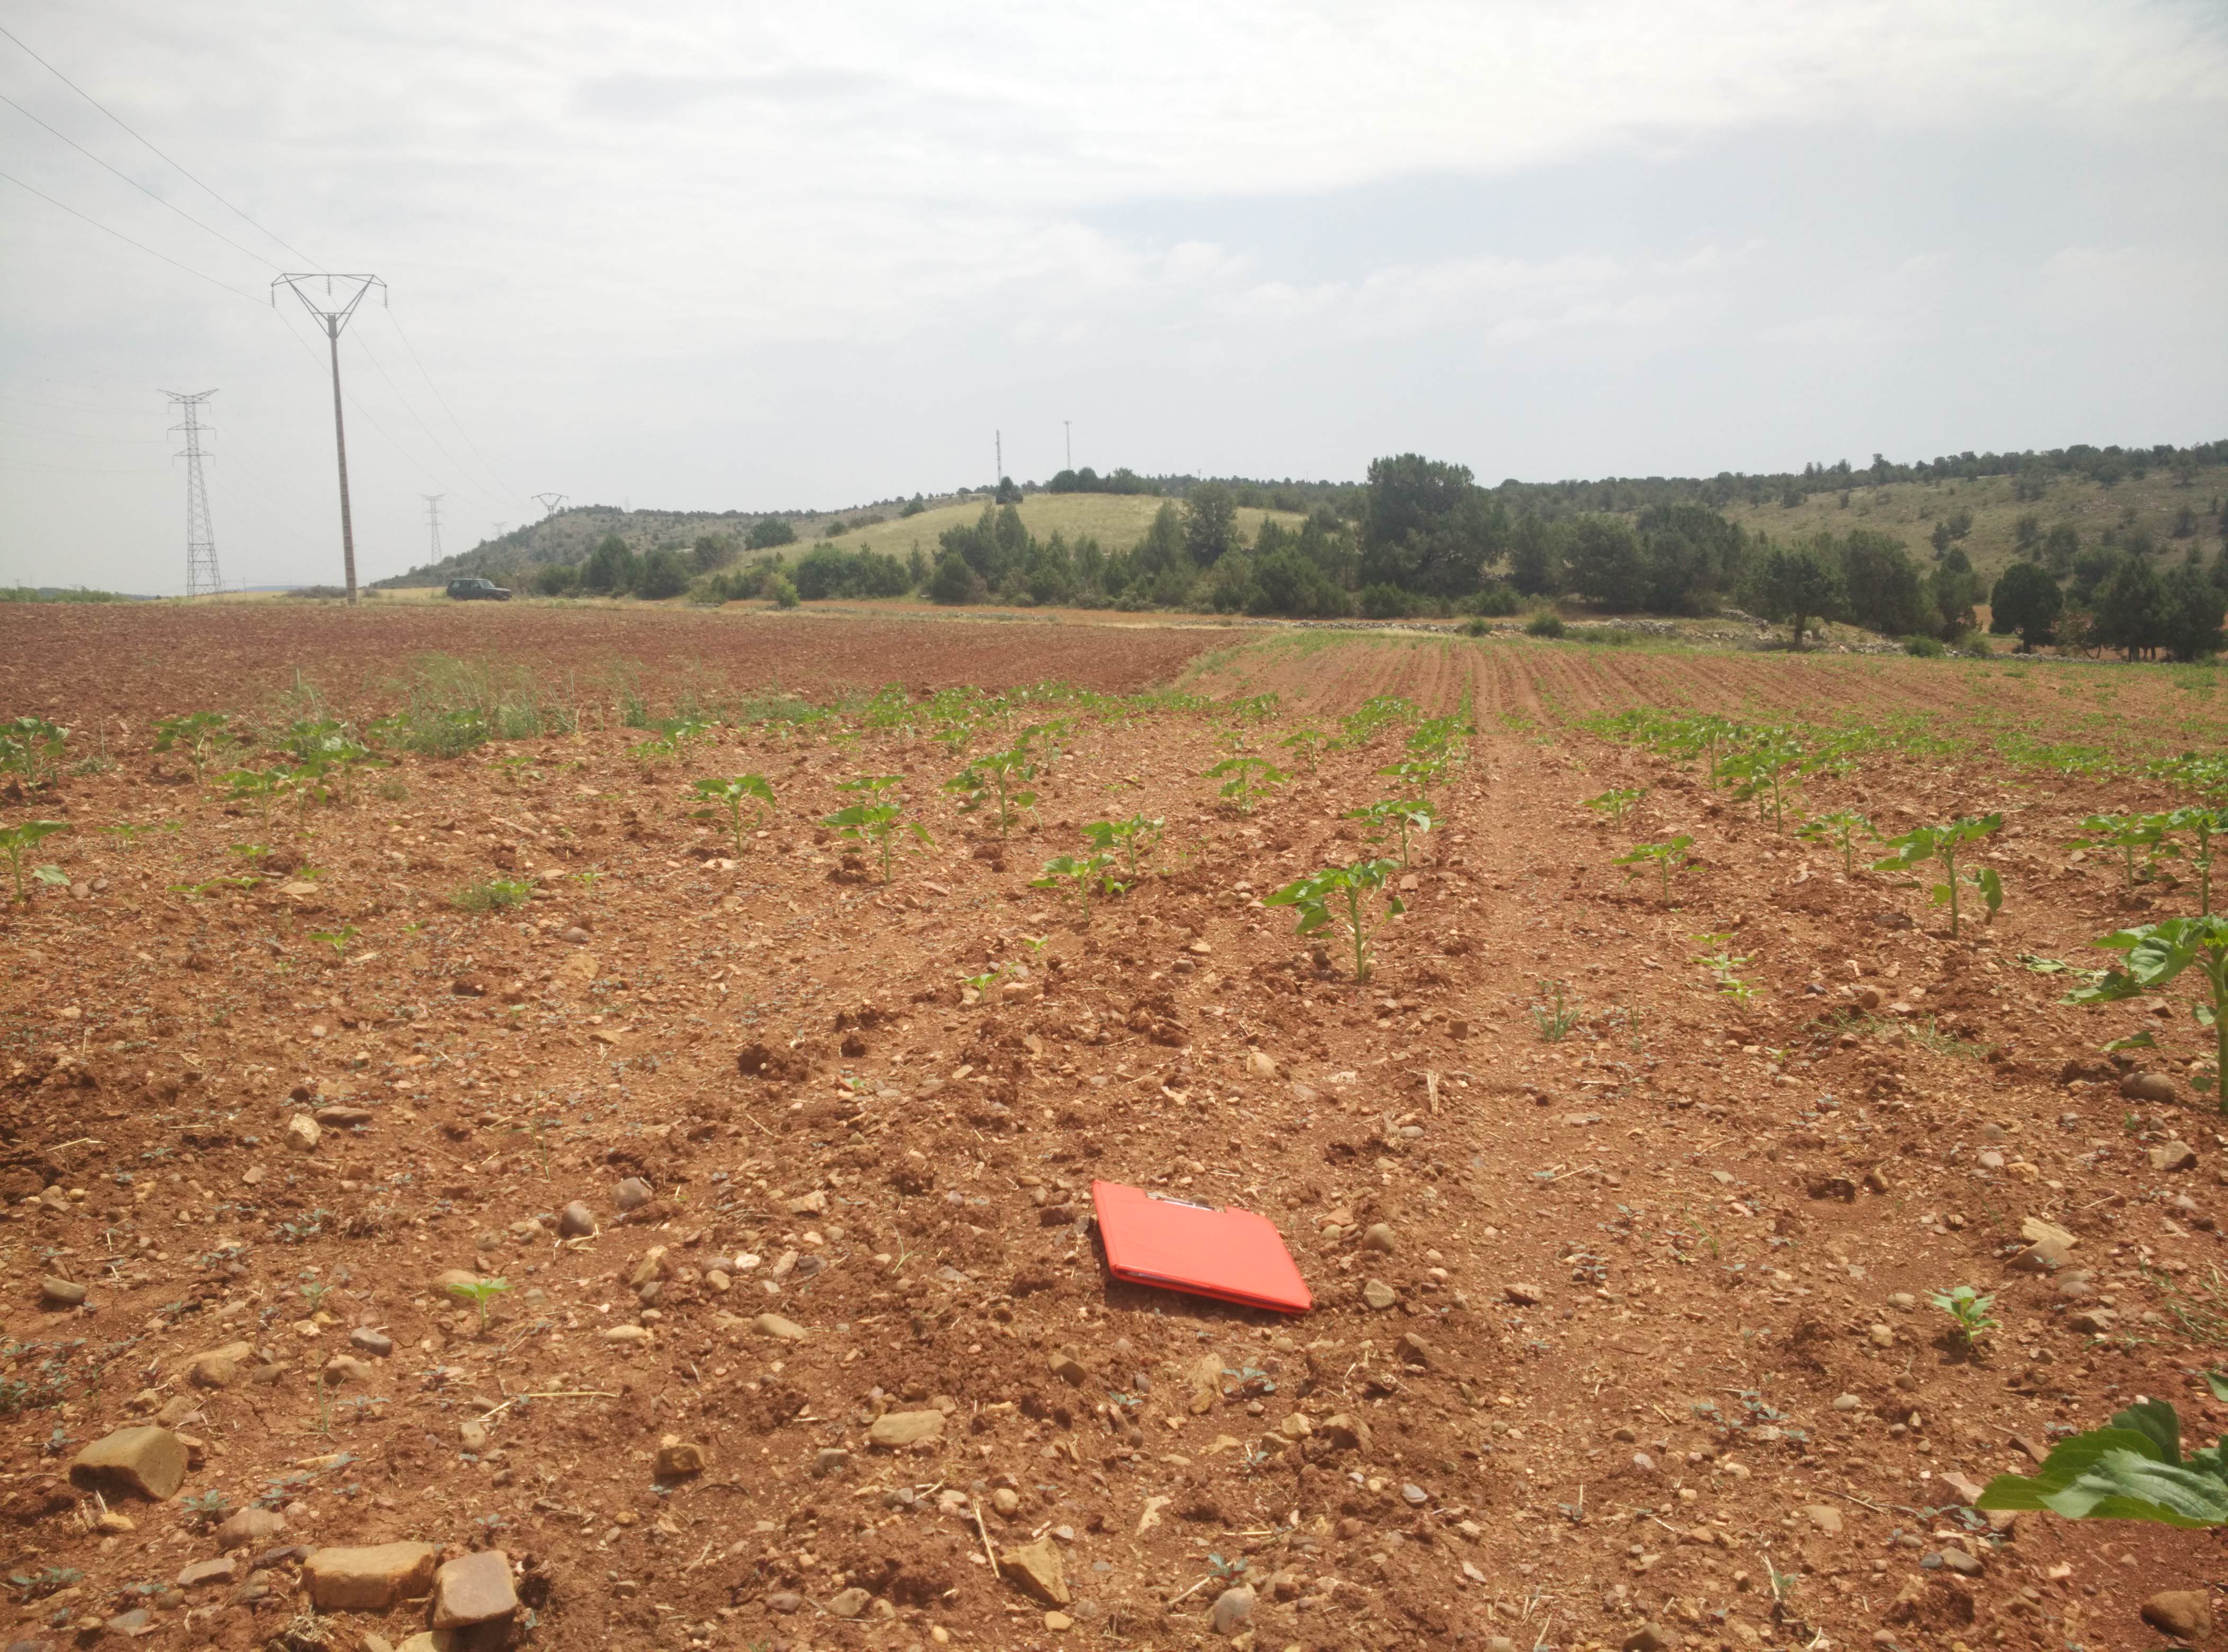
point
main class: Cropland
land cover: Sunflower
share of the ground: < 10 %
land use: Agriculture (excluding fallow land and kitchen gardens)
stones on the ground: < 10 %
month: July
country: ES
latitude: 40.9276
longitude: -2.0546
